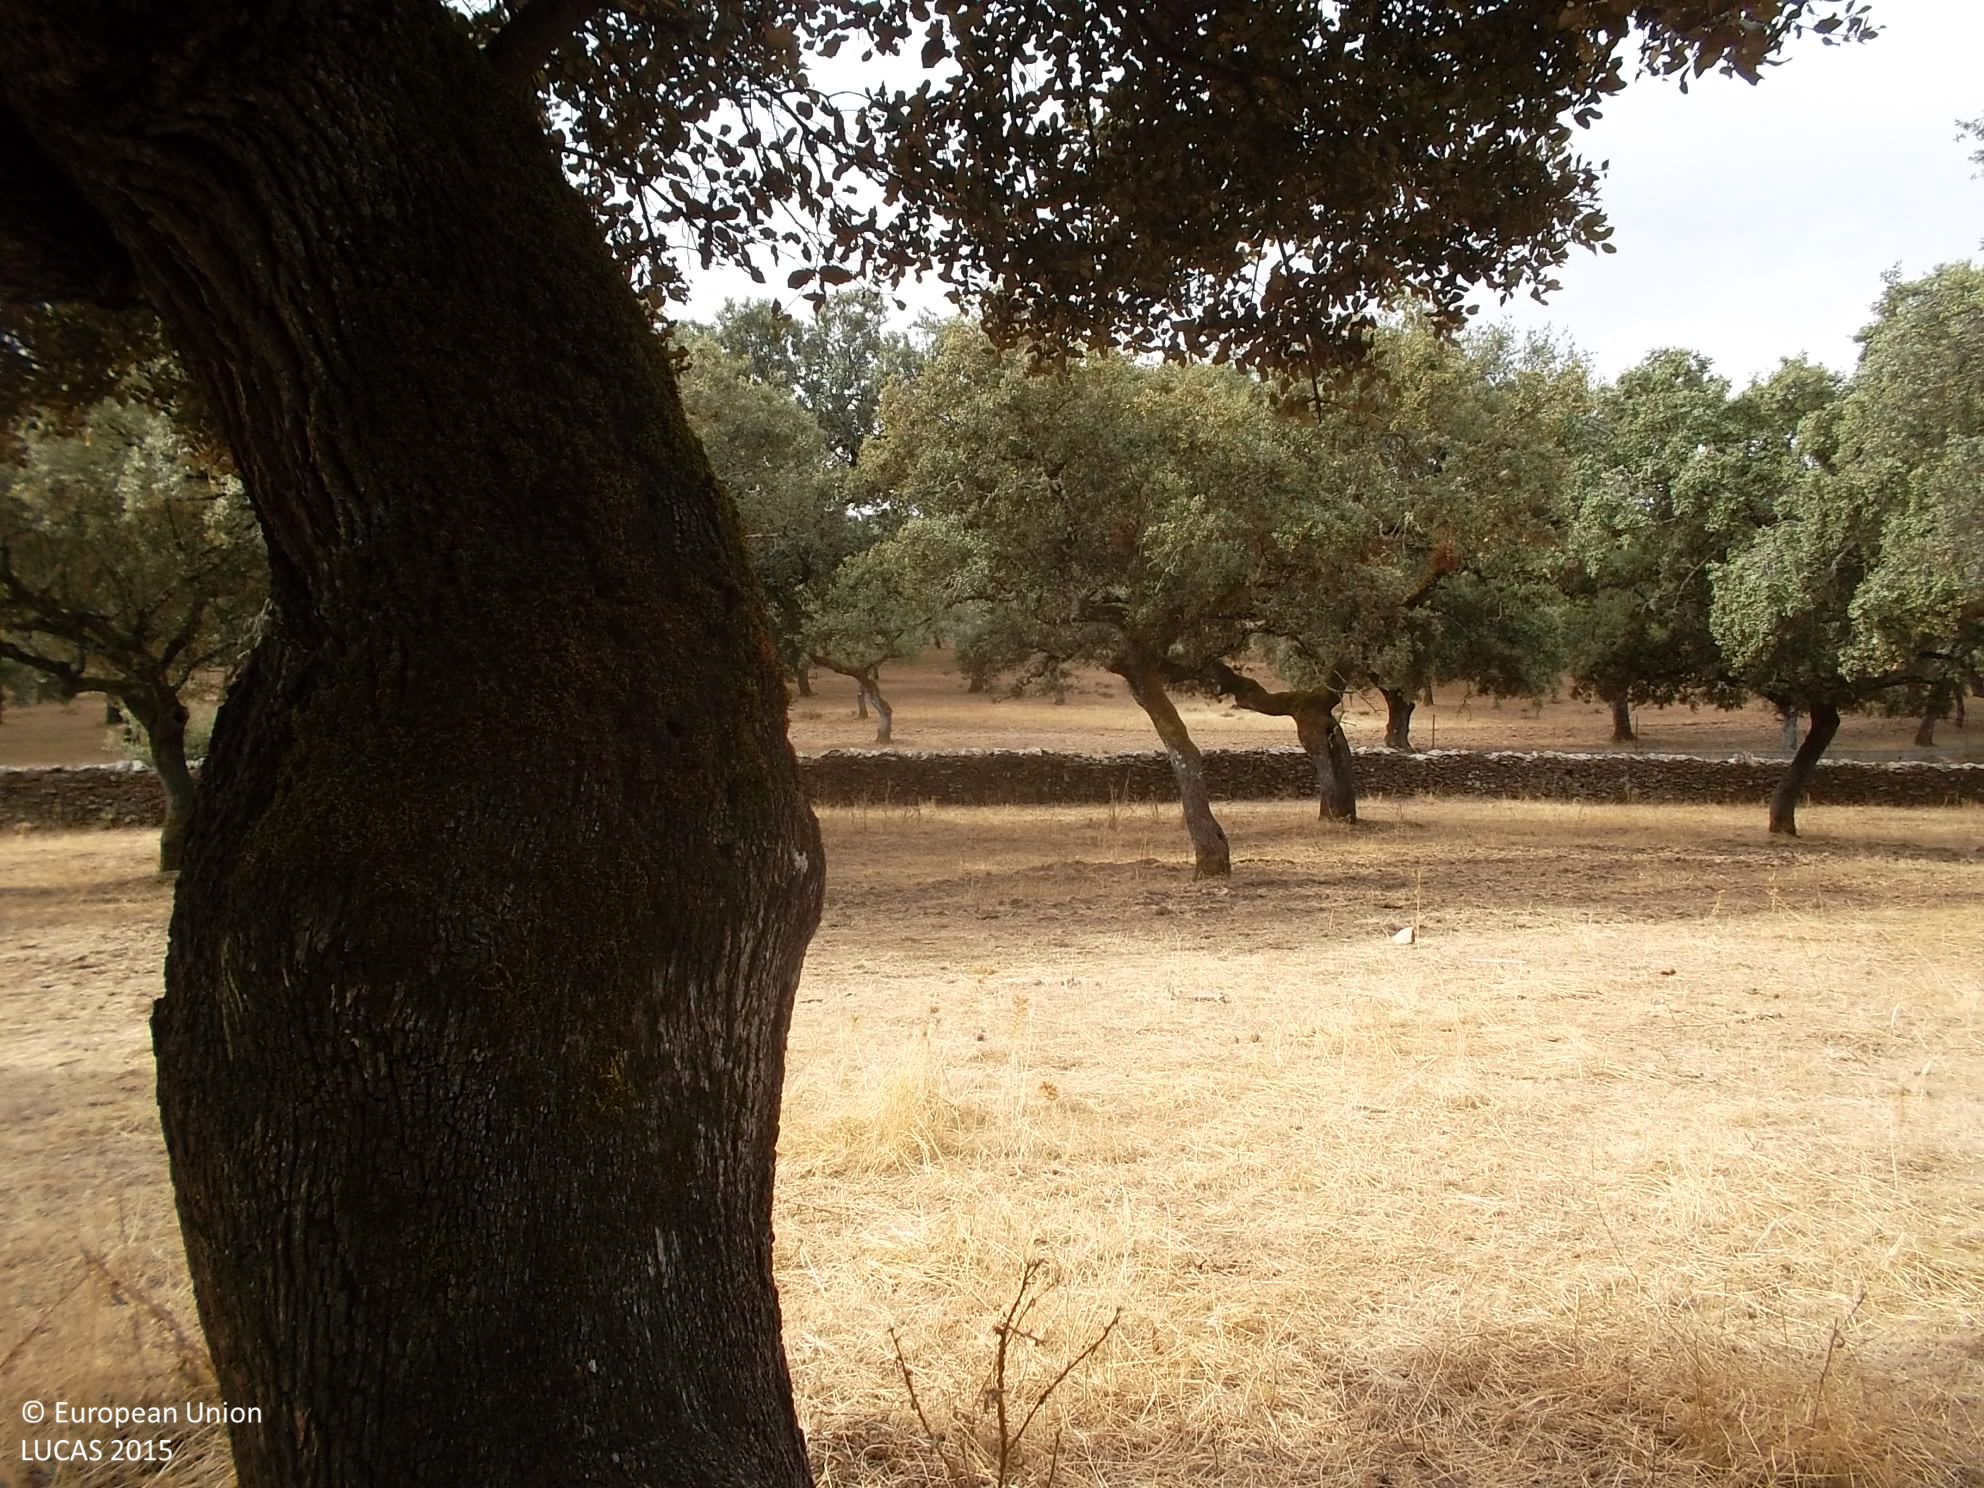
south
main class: Woodland
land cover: Broadleaved woodland
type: broadleaved evergreen forest
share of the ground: 50 - 75 %
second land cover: Grassland without tree/shrub cover
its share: > 75 %
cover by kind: broadleaved forest trees 60 %, herbaceous plants 40 %
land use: Forestry
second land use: Agriculture (excluding fallow land and kitchen gardens)
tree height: > 5 m
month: September
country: ES
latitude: 38.0856
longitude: -6.4977
